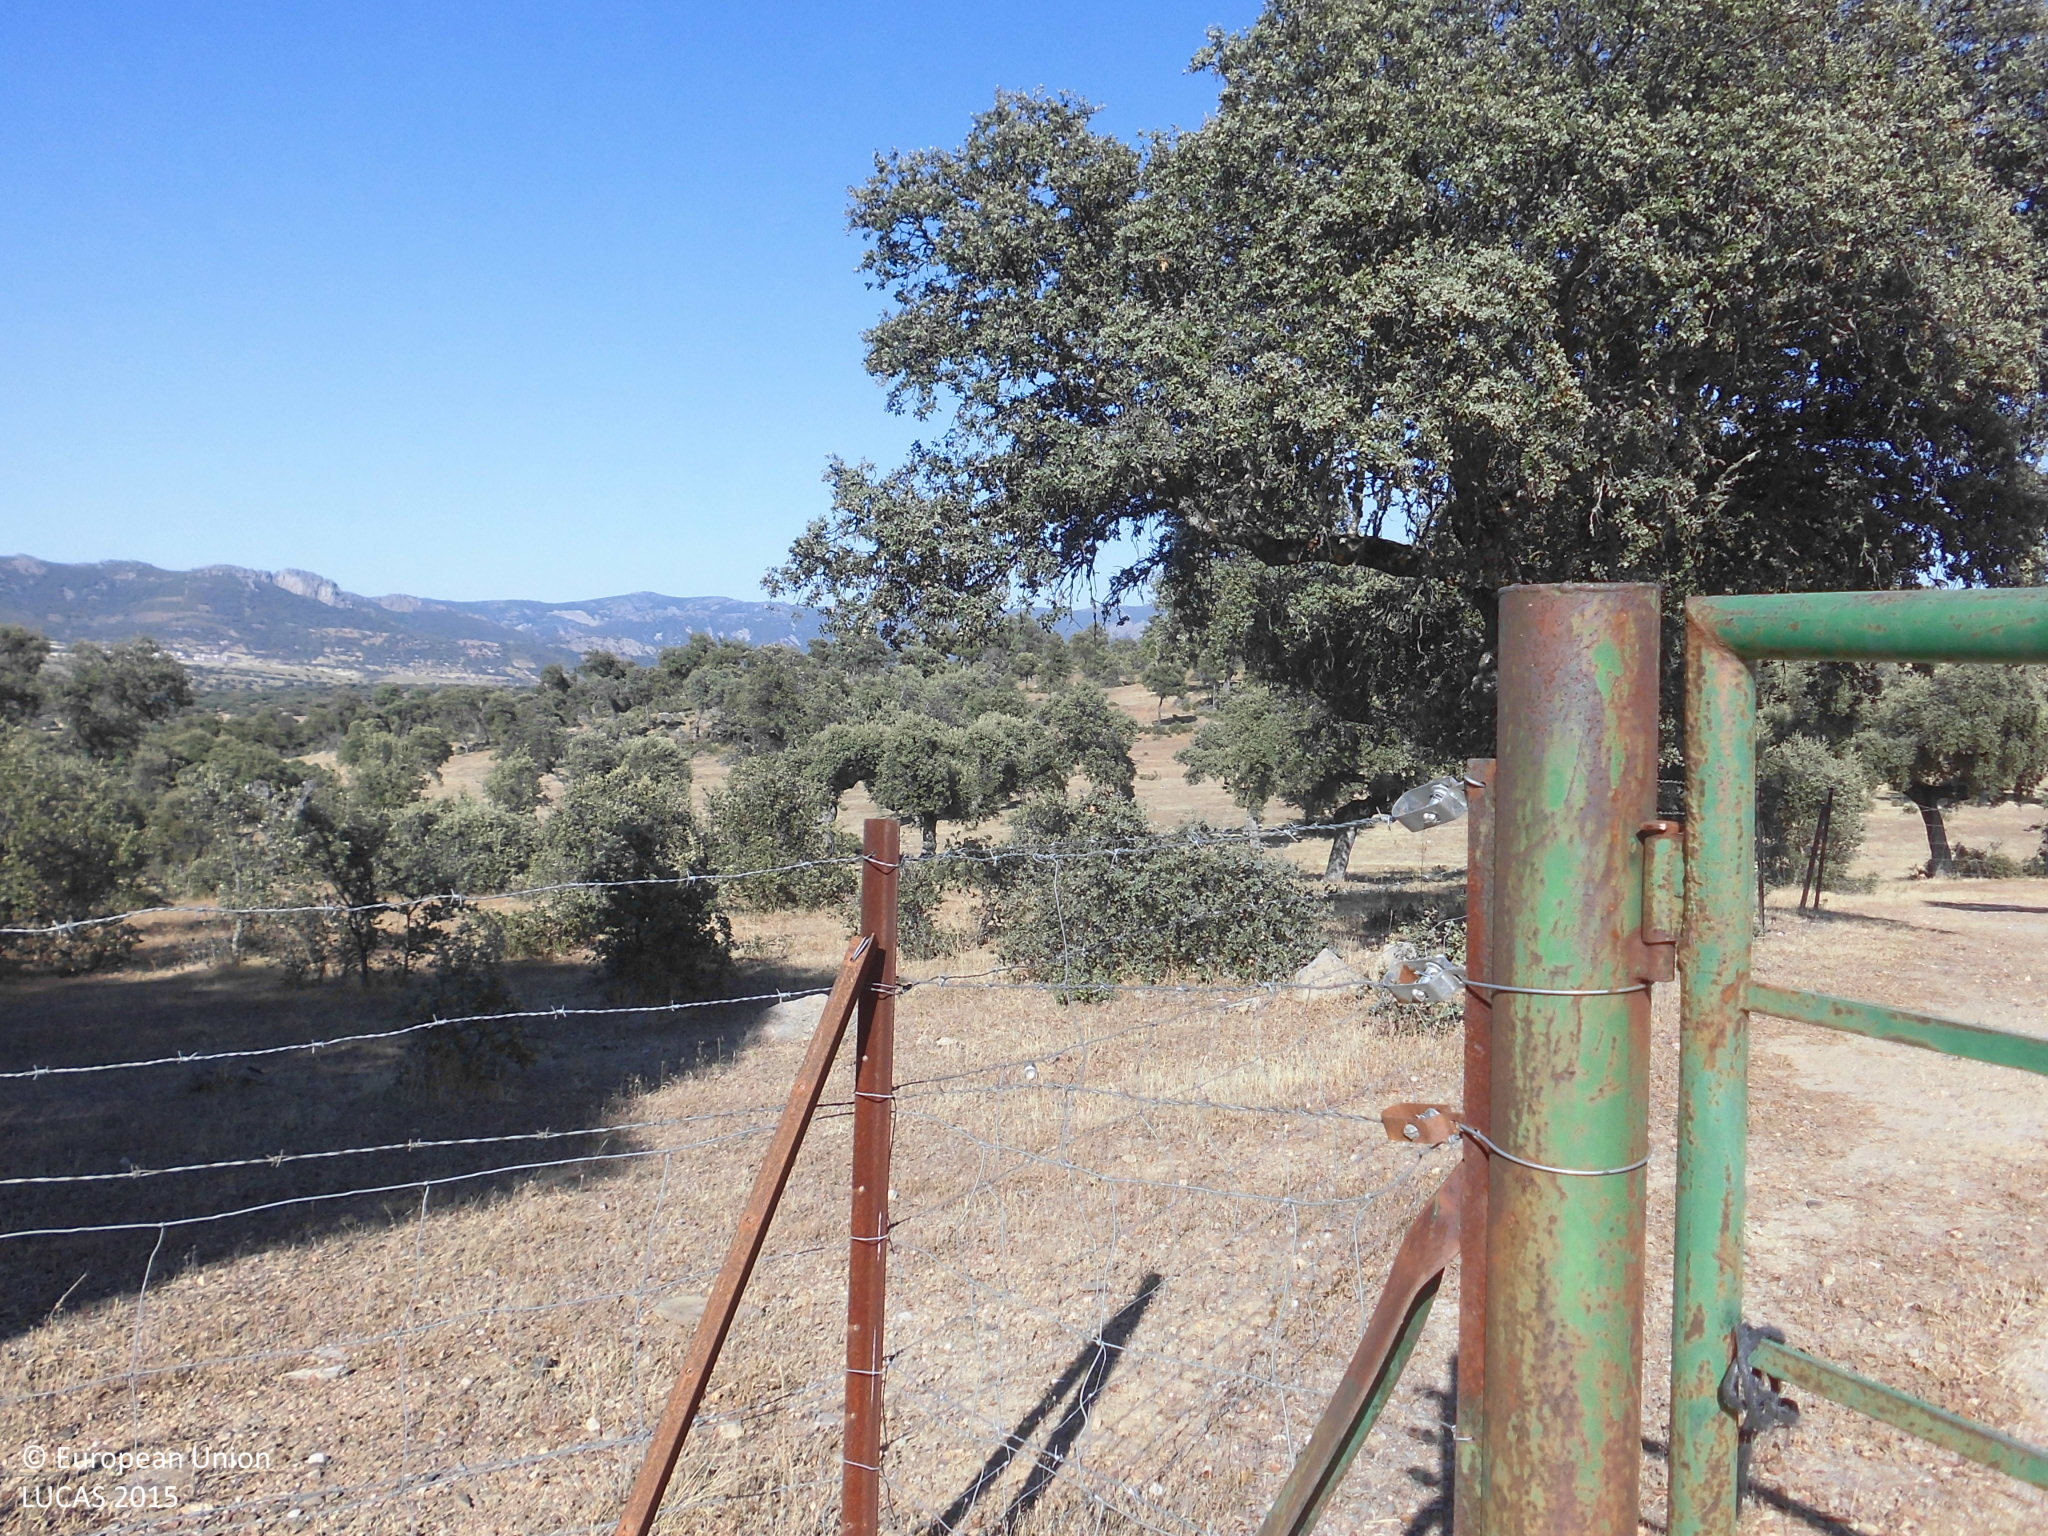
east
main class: Woodland
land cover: Broadleaved woodland
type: broadleaved evergreen forest
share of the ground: 50 - 75 %
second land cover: Grassland without tree/shrub cover
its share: > 75 %
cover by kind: broadleaved forest trees 60 %, herbaceous plants 40 %
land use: Forestry
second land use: Agriculture (excluding fallow land and kitchen gardens)
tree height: > 5 m
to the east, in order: Broadleaved woodland; Grassland without tree/shrub cover; Broadleaved woodland
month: July
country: ES
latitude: 39.5282
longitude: -5.5848
